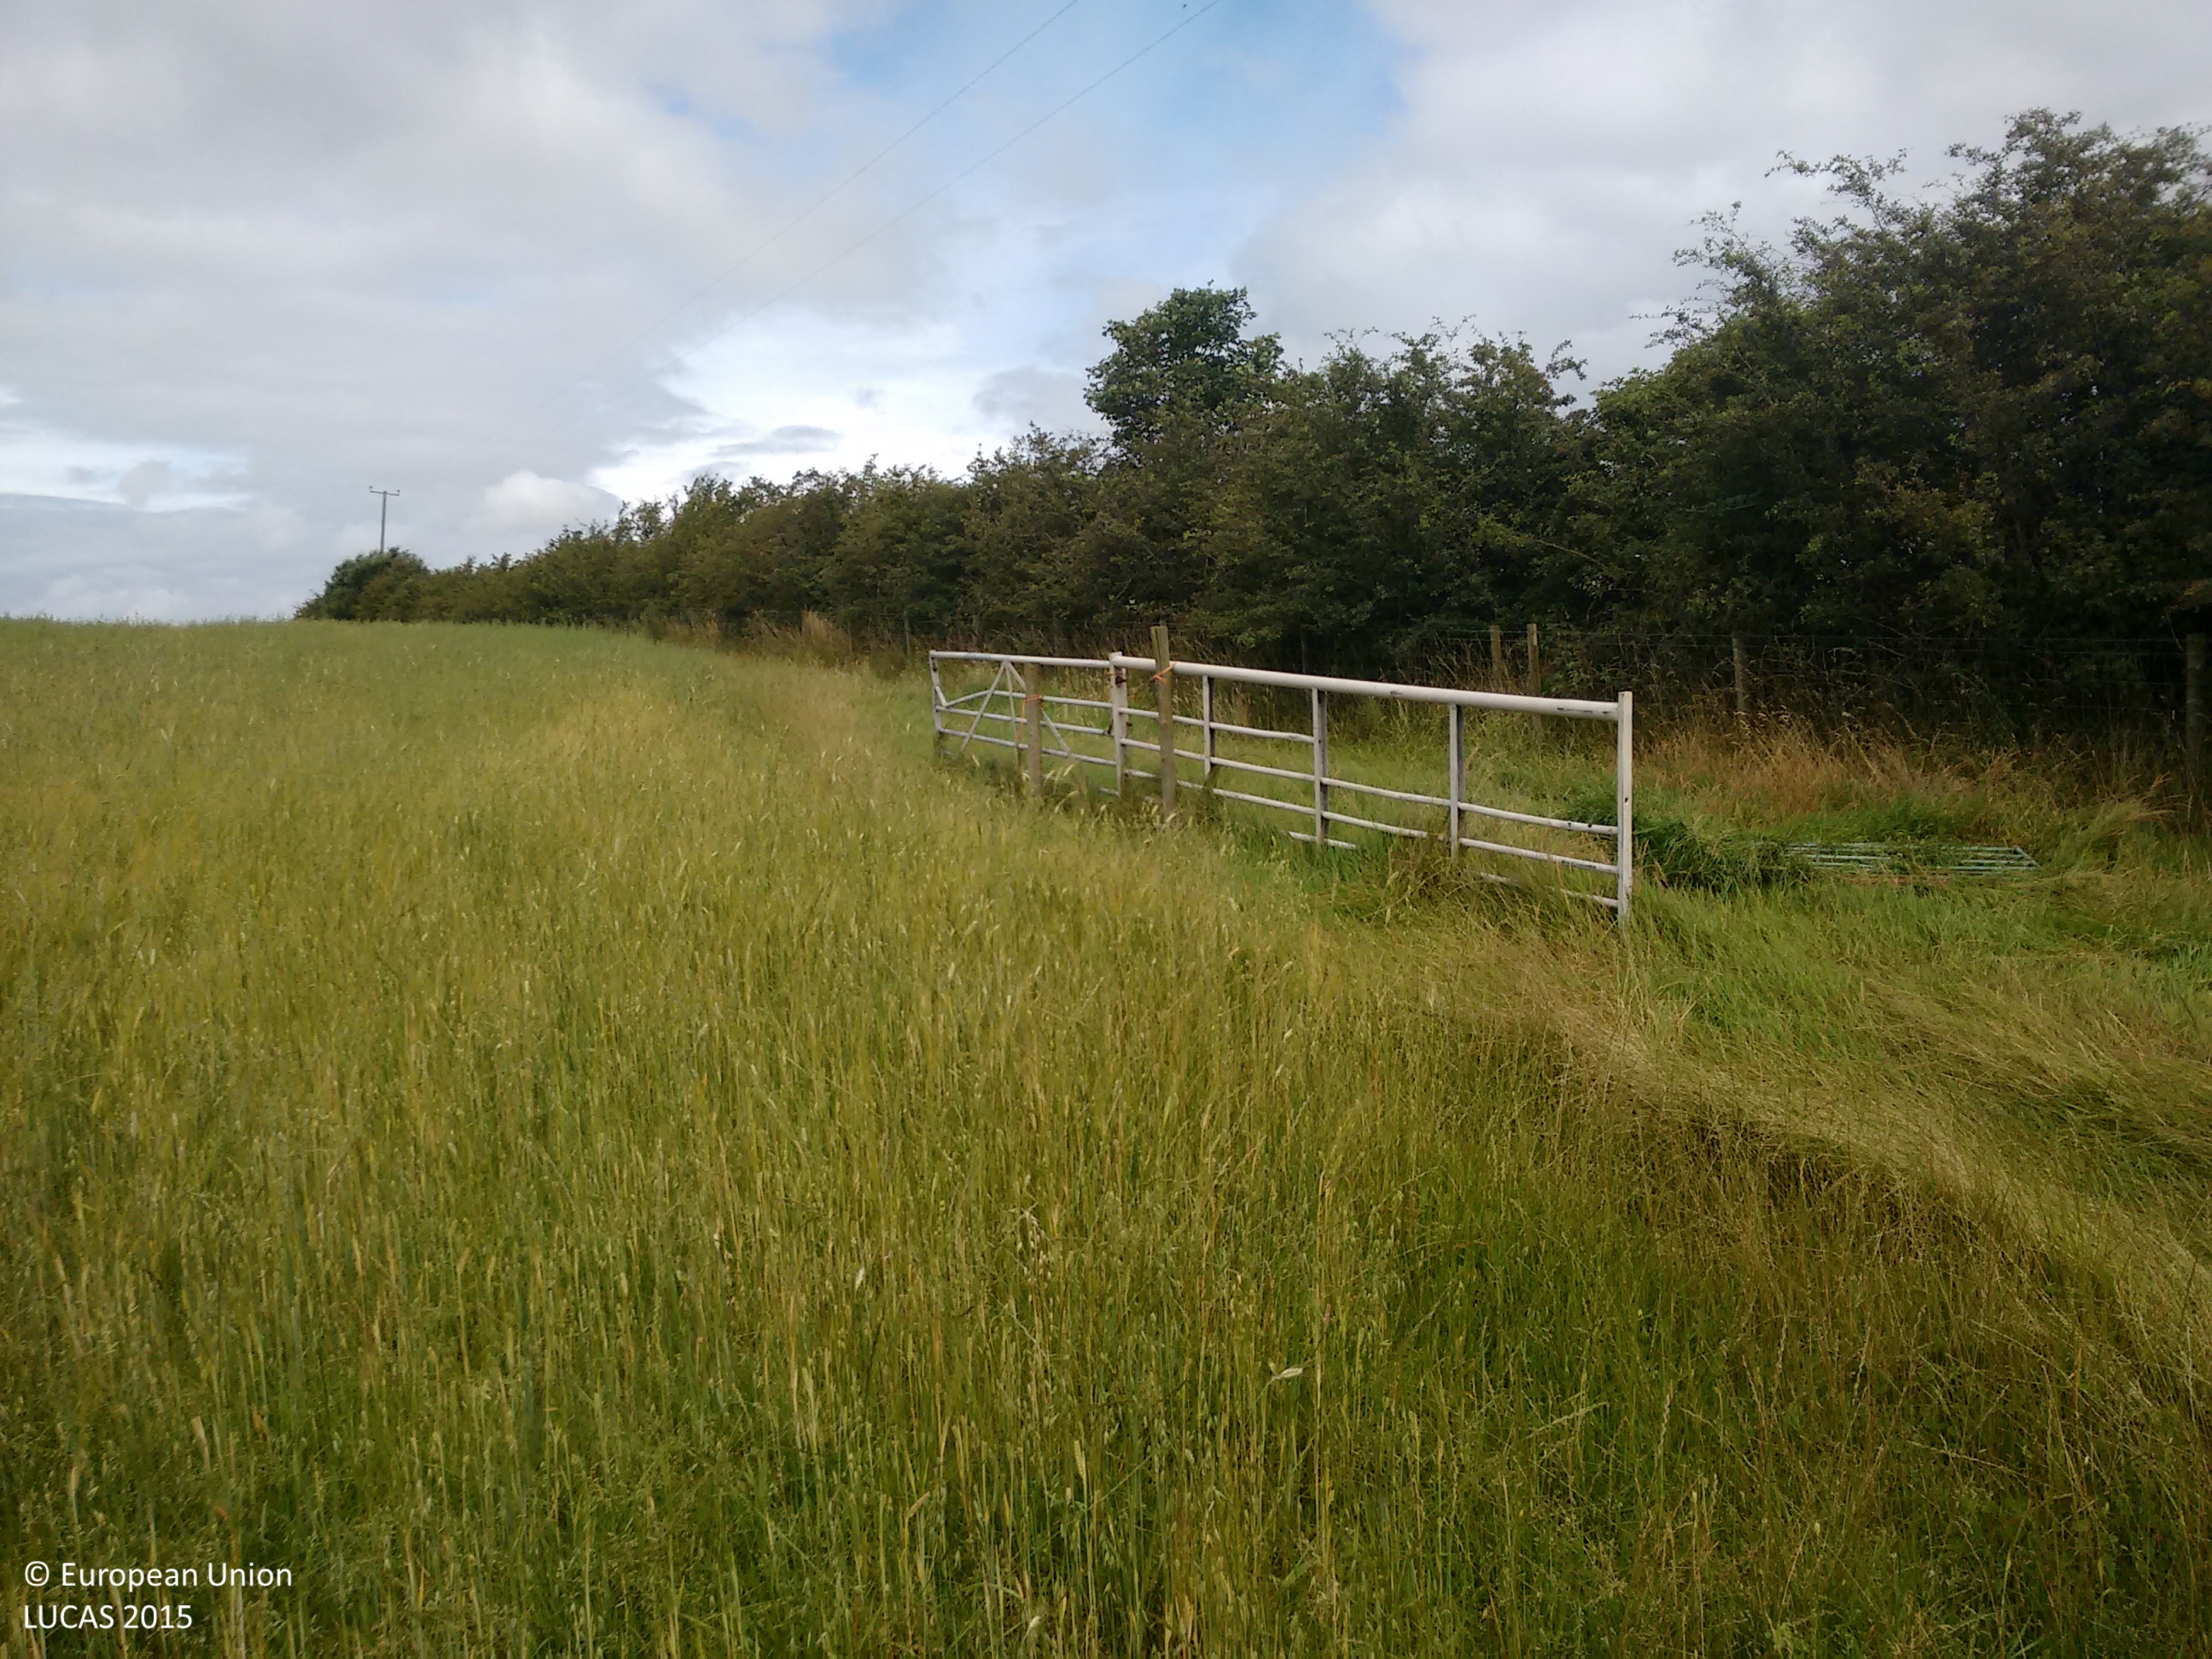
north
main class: Cropland
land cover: Oats
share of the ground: > 75 %
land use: Agriculture (excluding fallow land and kitchen gardens)
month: August
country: GB
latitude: 54.6489
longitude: -3.3289
